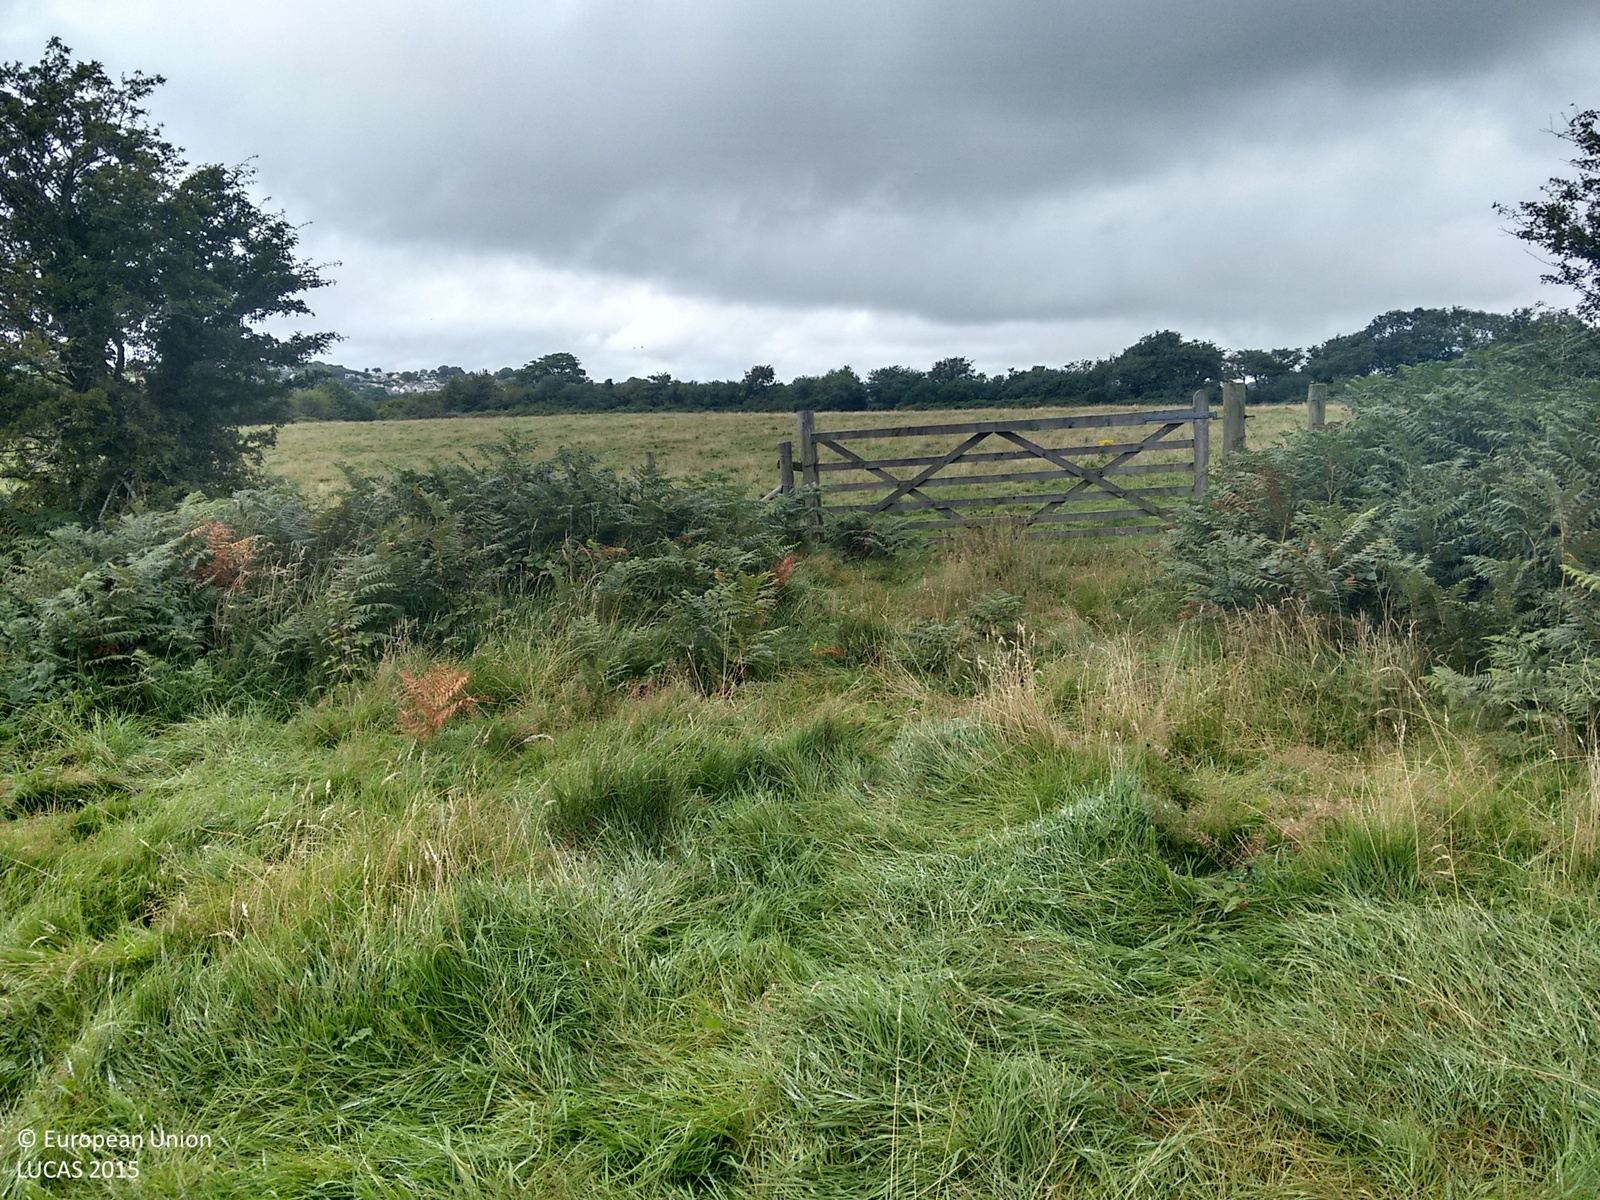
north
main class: Shrubland
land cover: Shrubland with sparse tree cover
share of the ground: > 75 %
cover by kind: herbaceous plants 65 %, shrubs 30 %, broadleaved forest trees 5 %
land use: Agriculture (excluding fallow land and kitchen gardens)
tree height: < 5 m
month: August
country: GB
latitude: 51.7625
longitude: -4.7302
